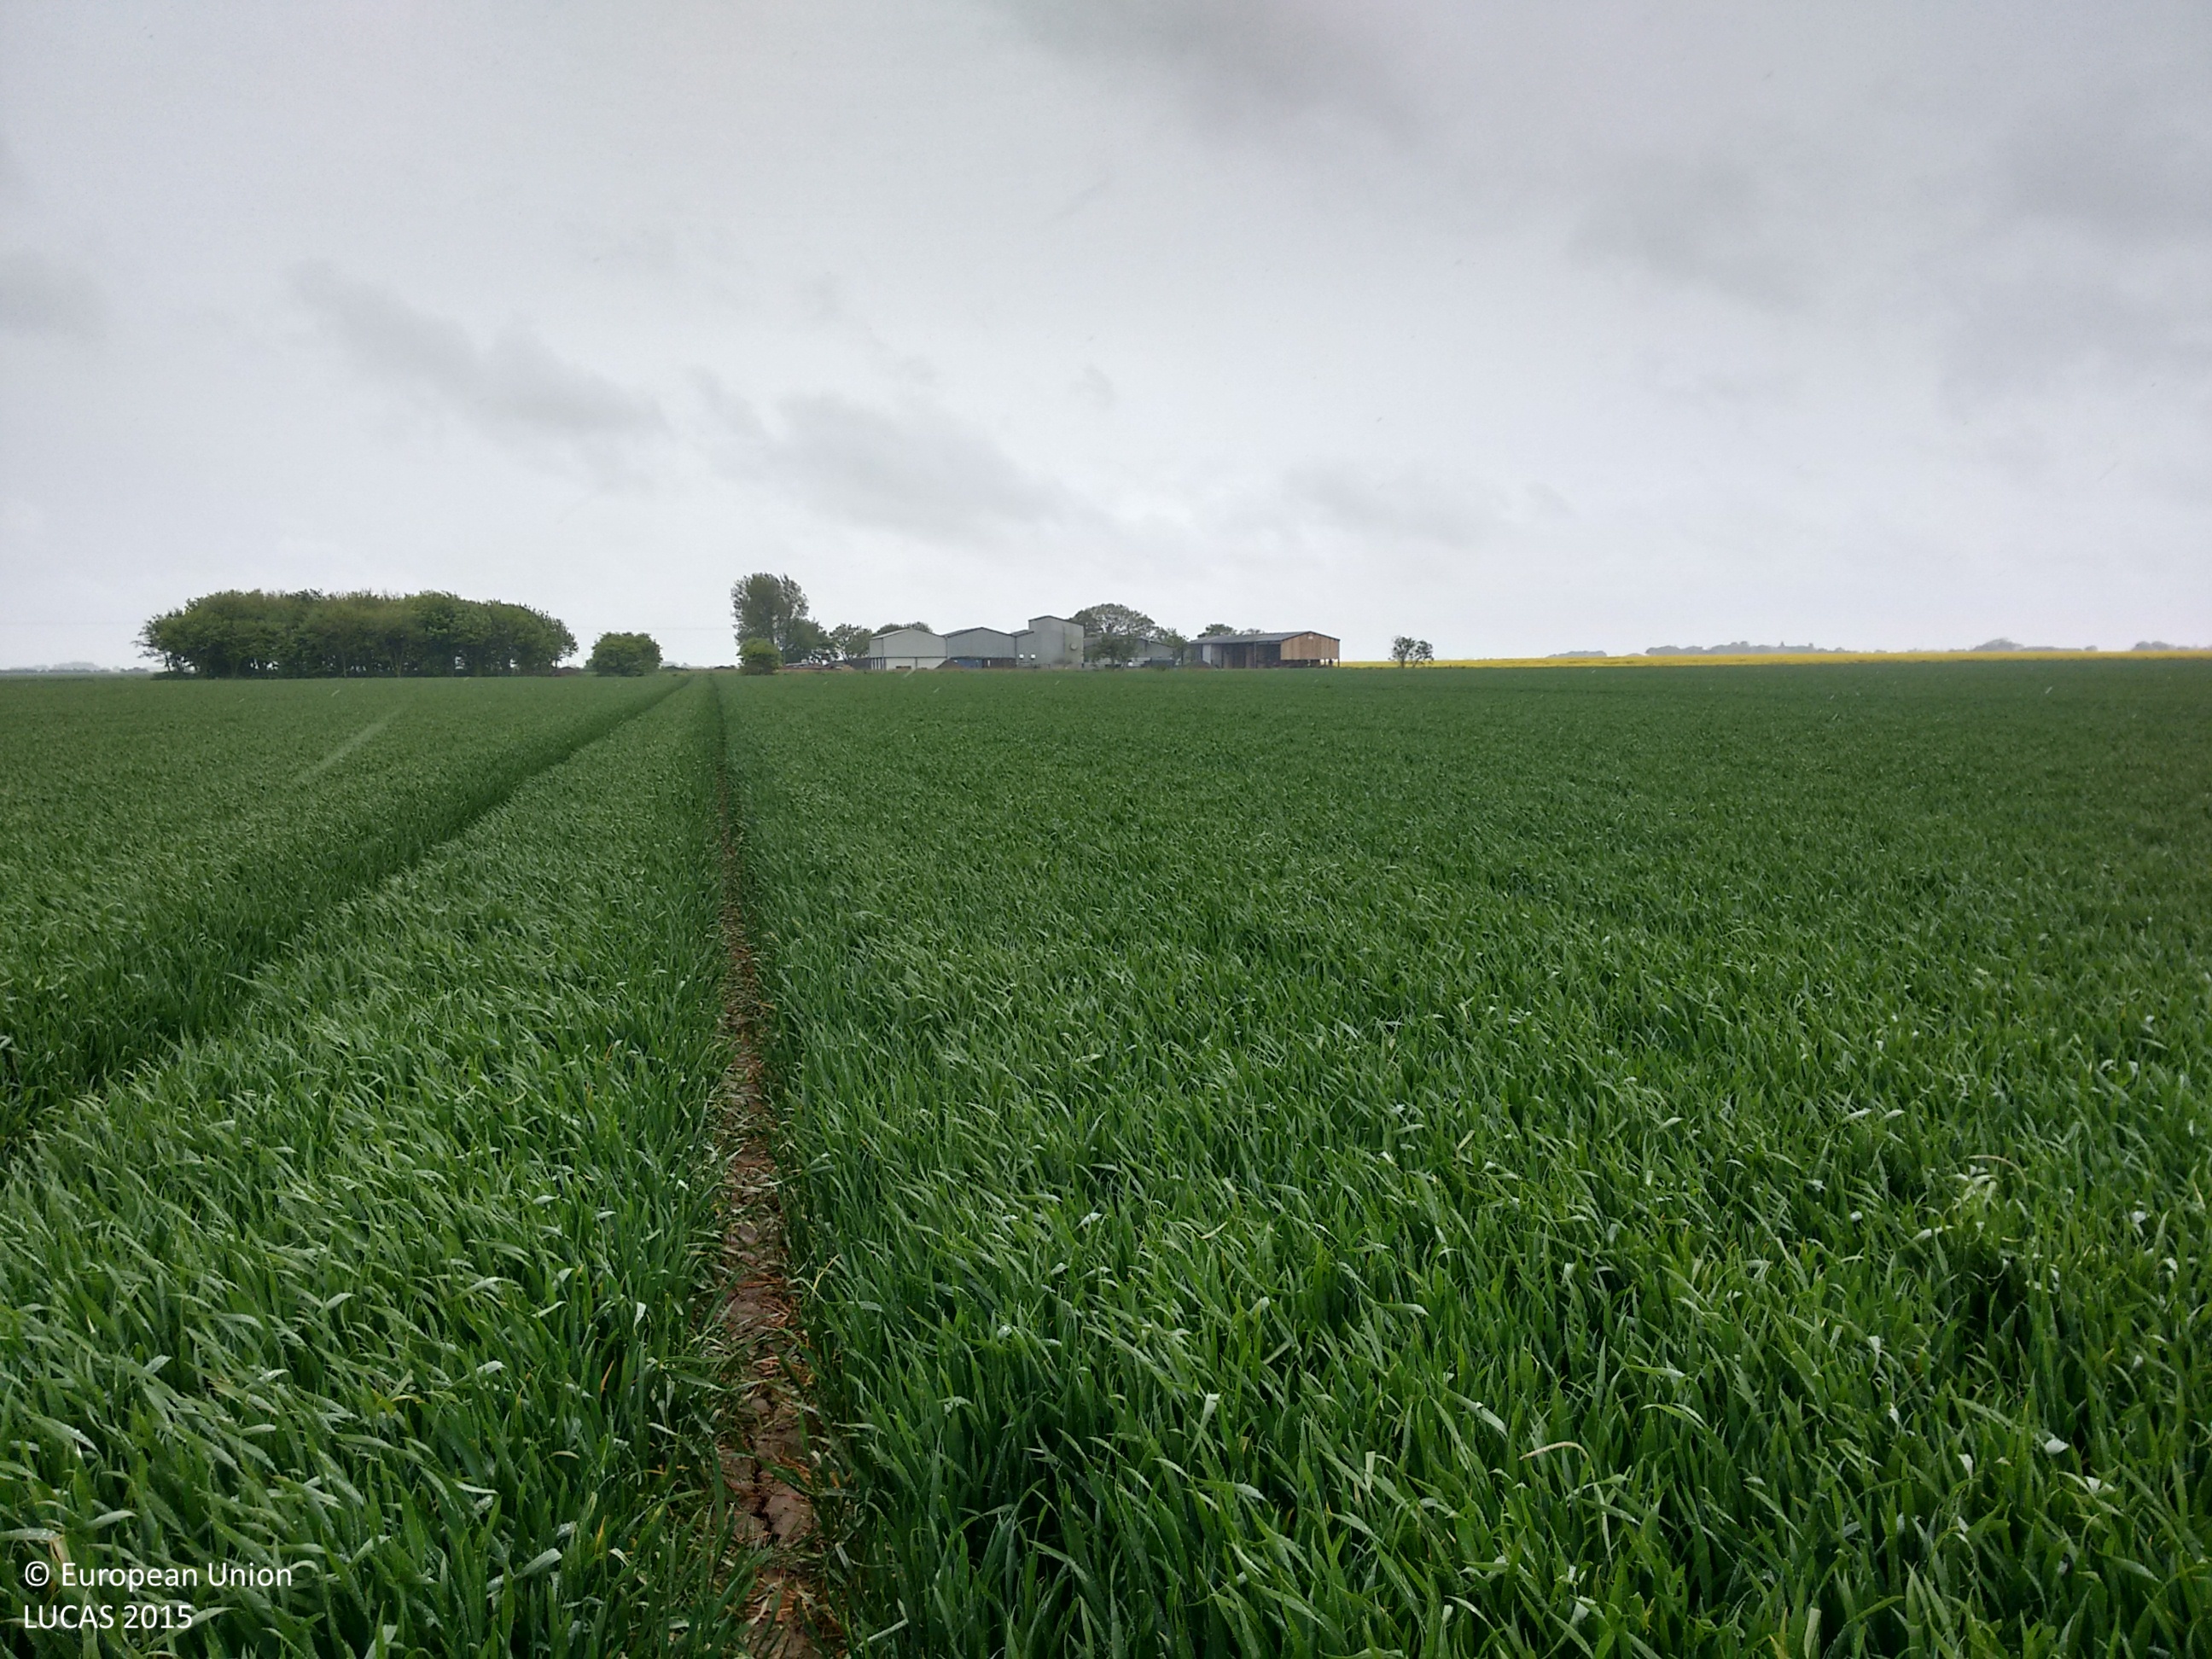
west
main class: Cropland
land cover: Common wheat
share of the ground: > 75 %
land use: Agriculture (excluding fallow land and kitchen gardens)
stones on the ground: < 10 %
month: May
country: GB
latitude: 53.6700
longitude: -0.0674
